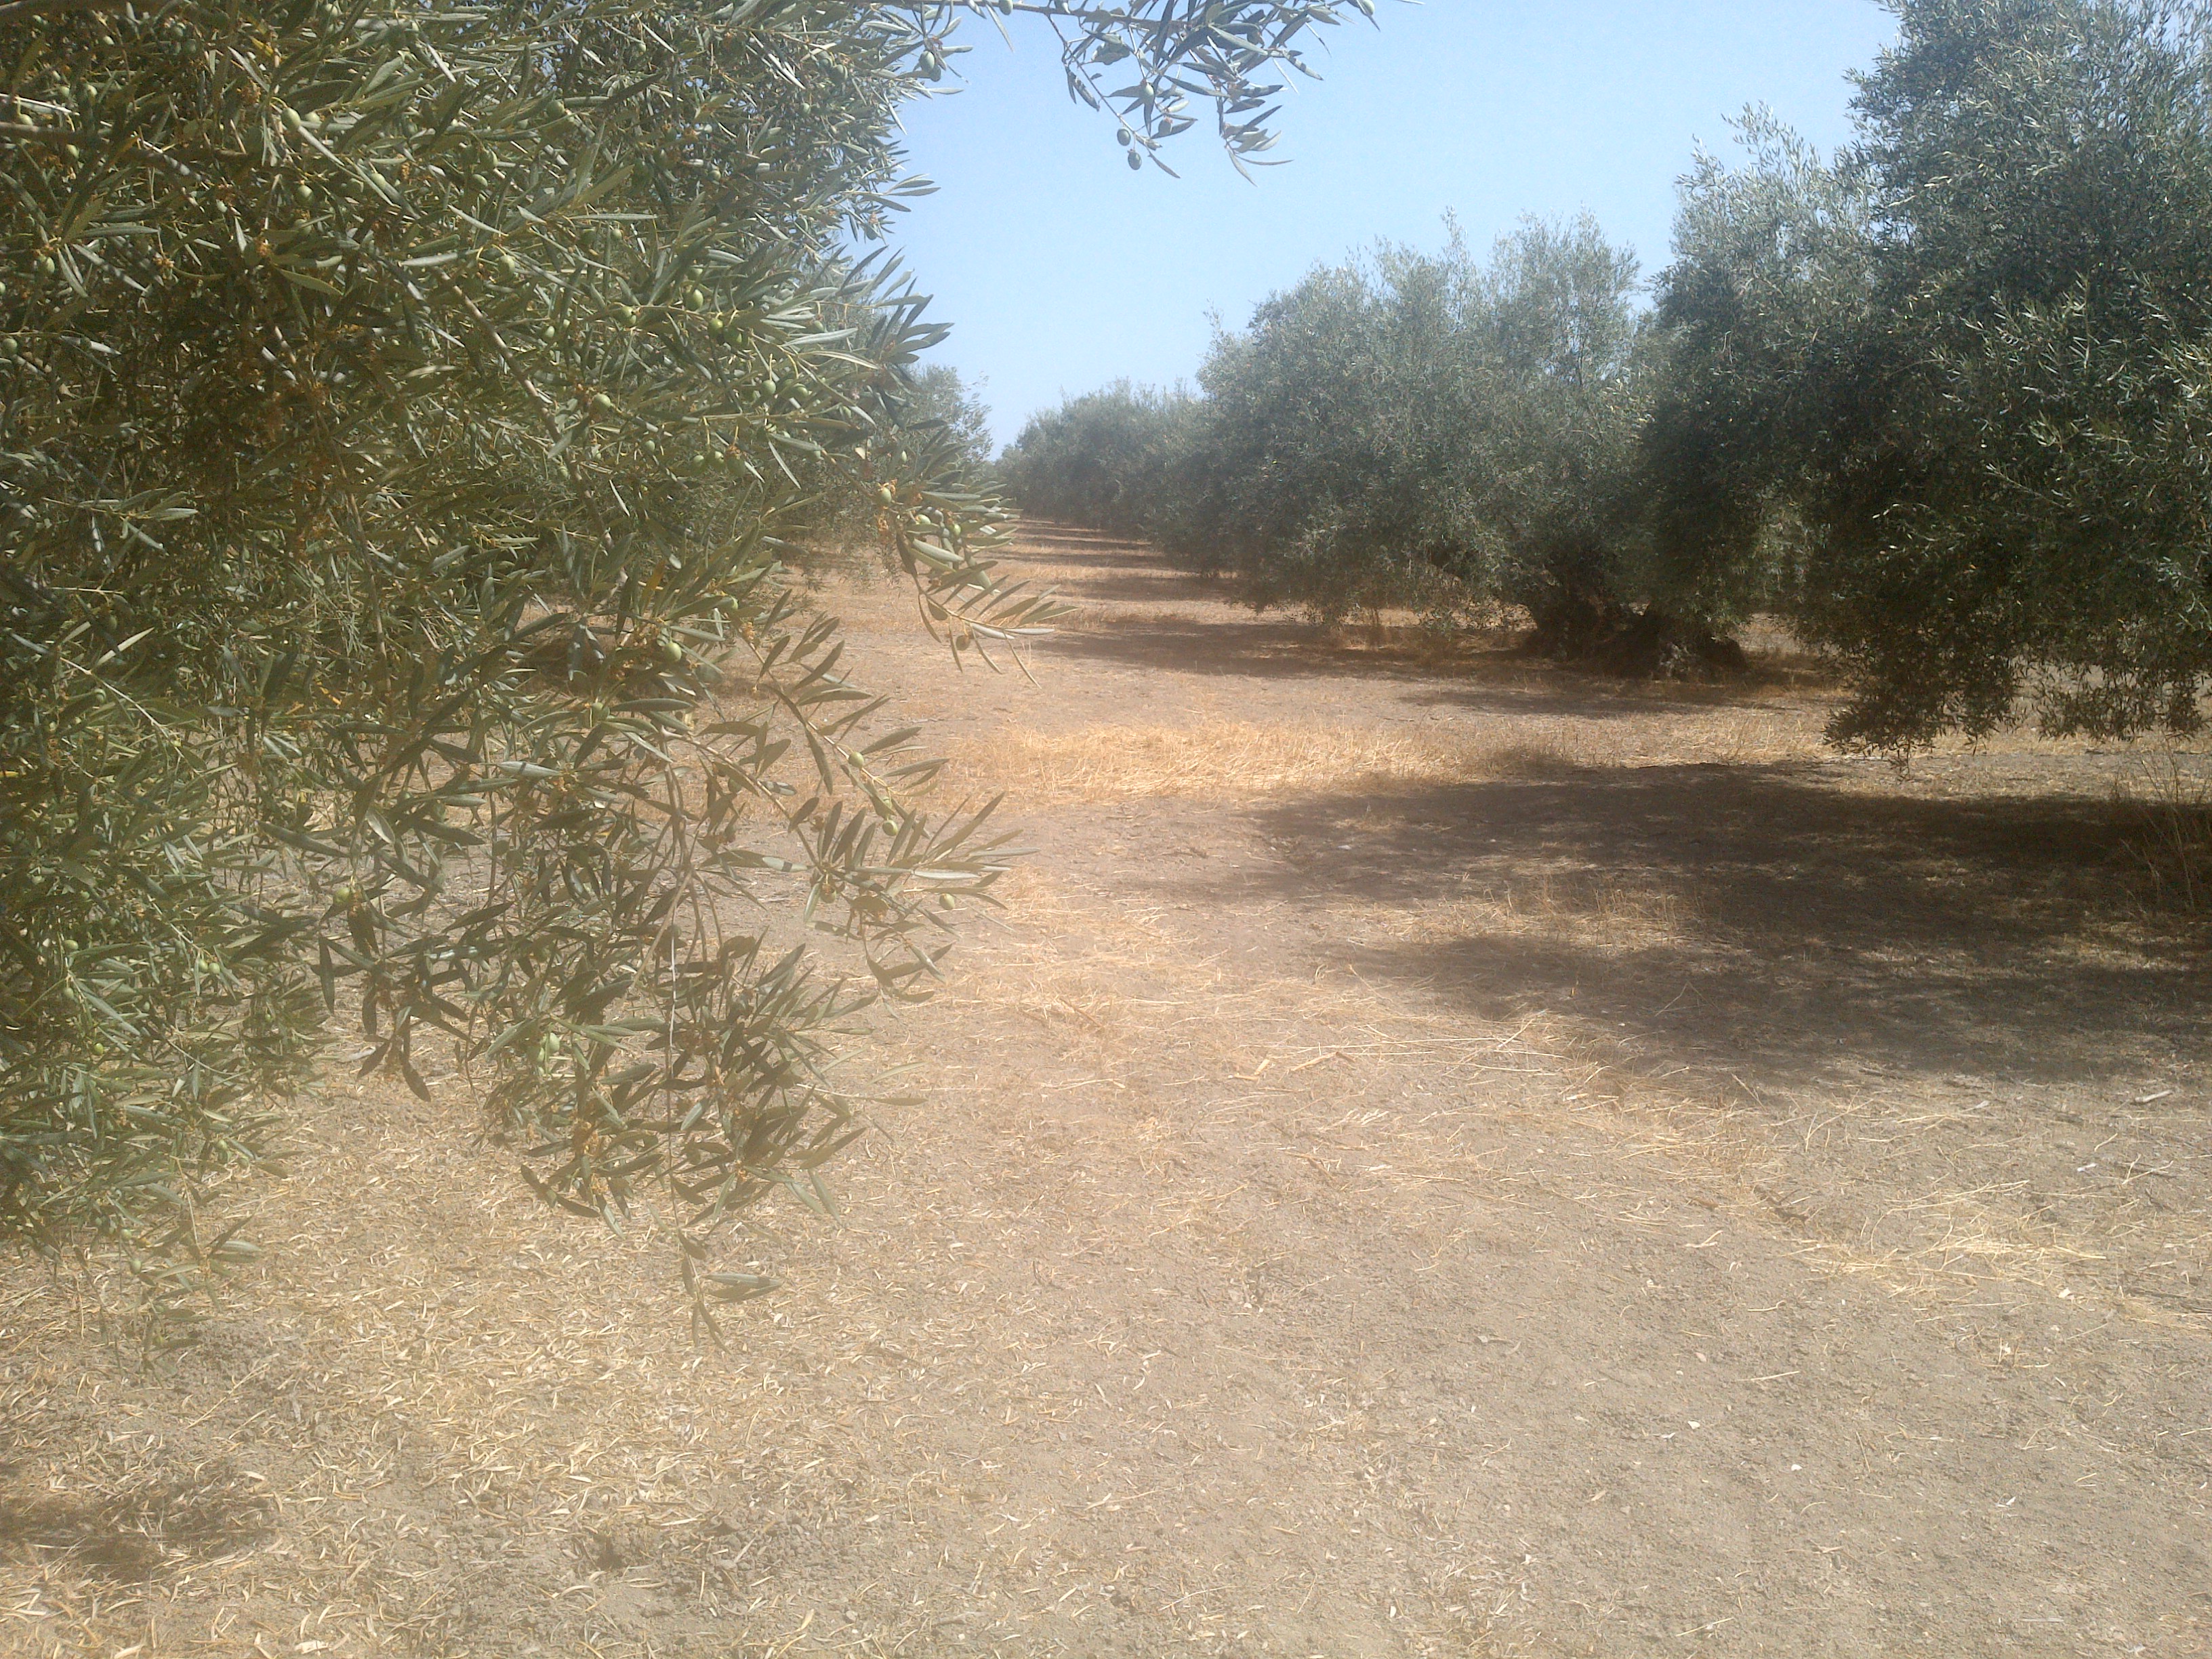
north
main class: Cropland
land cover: Olive groves
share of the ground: 50 - 75 %
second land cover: Spontaneously vegetated surfaces
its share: 10 - 25 %
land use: Agriculture (excluding fallow land and kitchen gardens)
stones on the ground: < 10 %
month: July
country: ES
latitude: 37.4280
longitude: -4.5705
